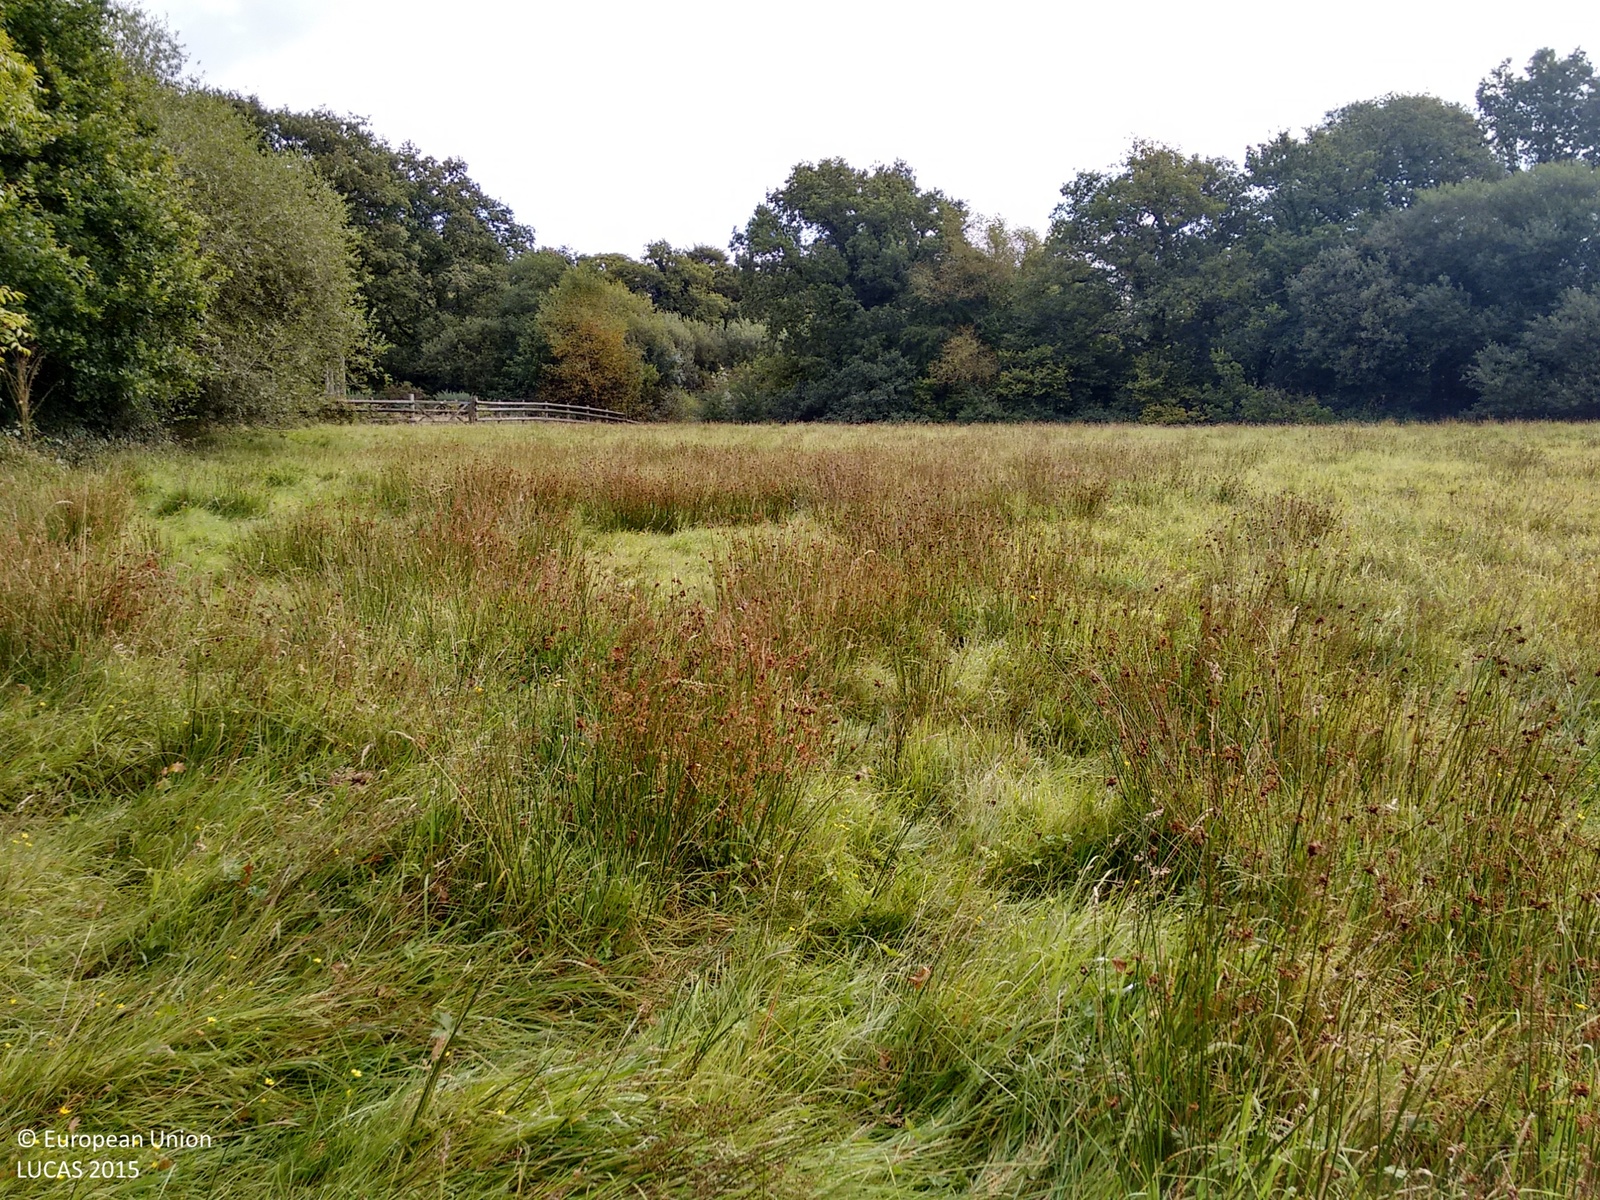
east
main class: Grassland
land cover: Grassland without tree/shrub cover
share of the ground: > 75 %
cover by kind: herbaceous plants 100 %
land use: Agriculture (excluding fallow land and kitchen gardens)
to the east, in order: Grassland without tree/shrub cover; Broadleaved woodland; Fences; Broadleaved woodland; Fences; Grass margins; Paved roads, cycling and walking lanes; Grass margins; Broadleaved woodland; Rivers and streams; Broadleaved woodland; Fences; Broadleaved woodland; Grassland without tree/shrub cover
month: September
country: GB
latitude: 50.8314
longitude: -4.1390
